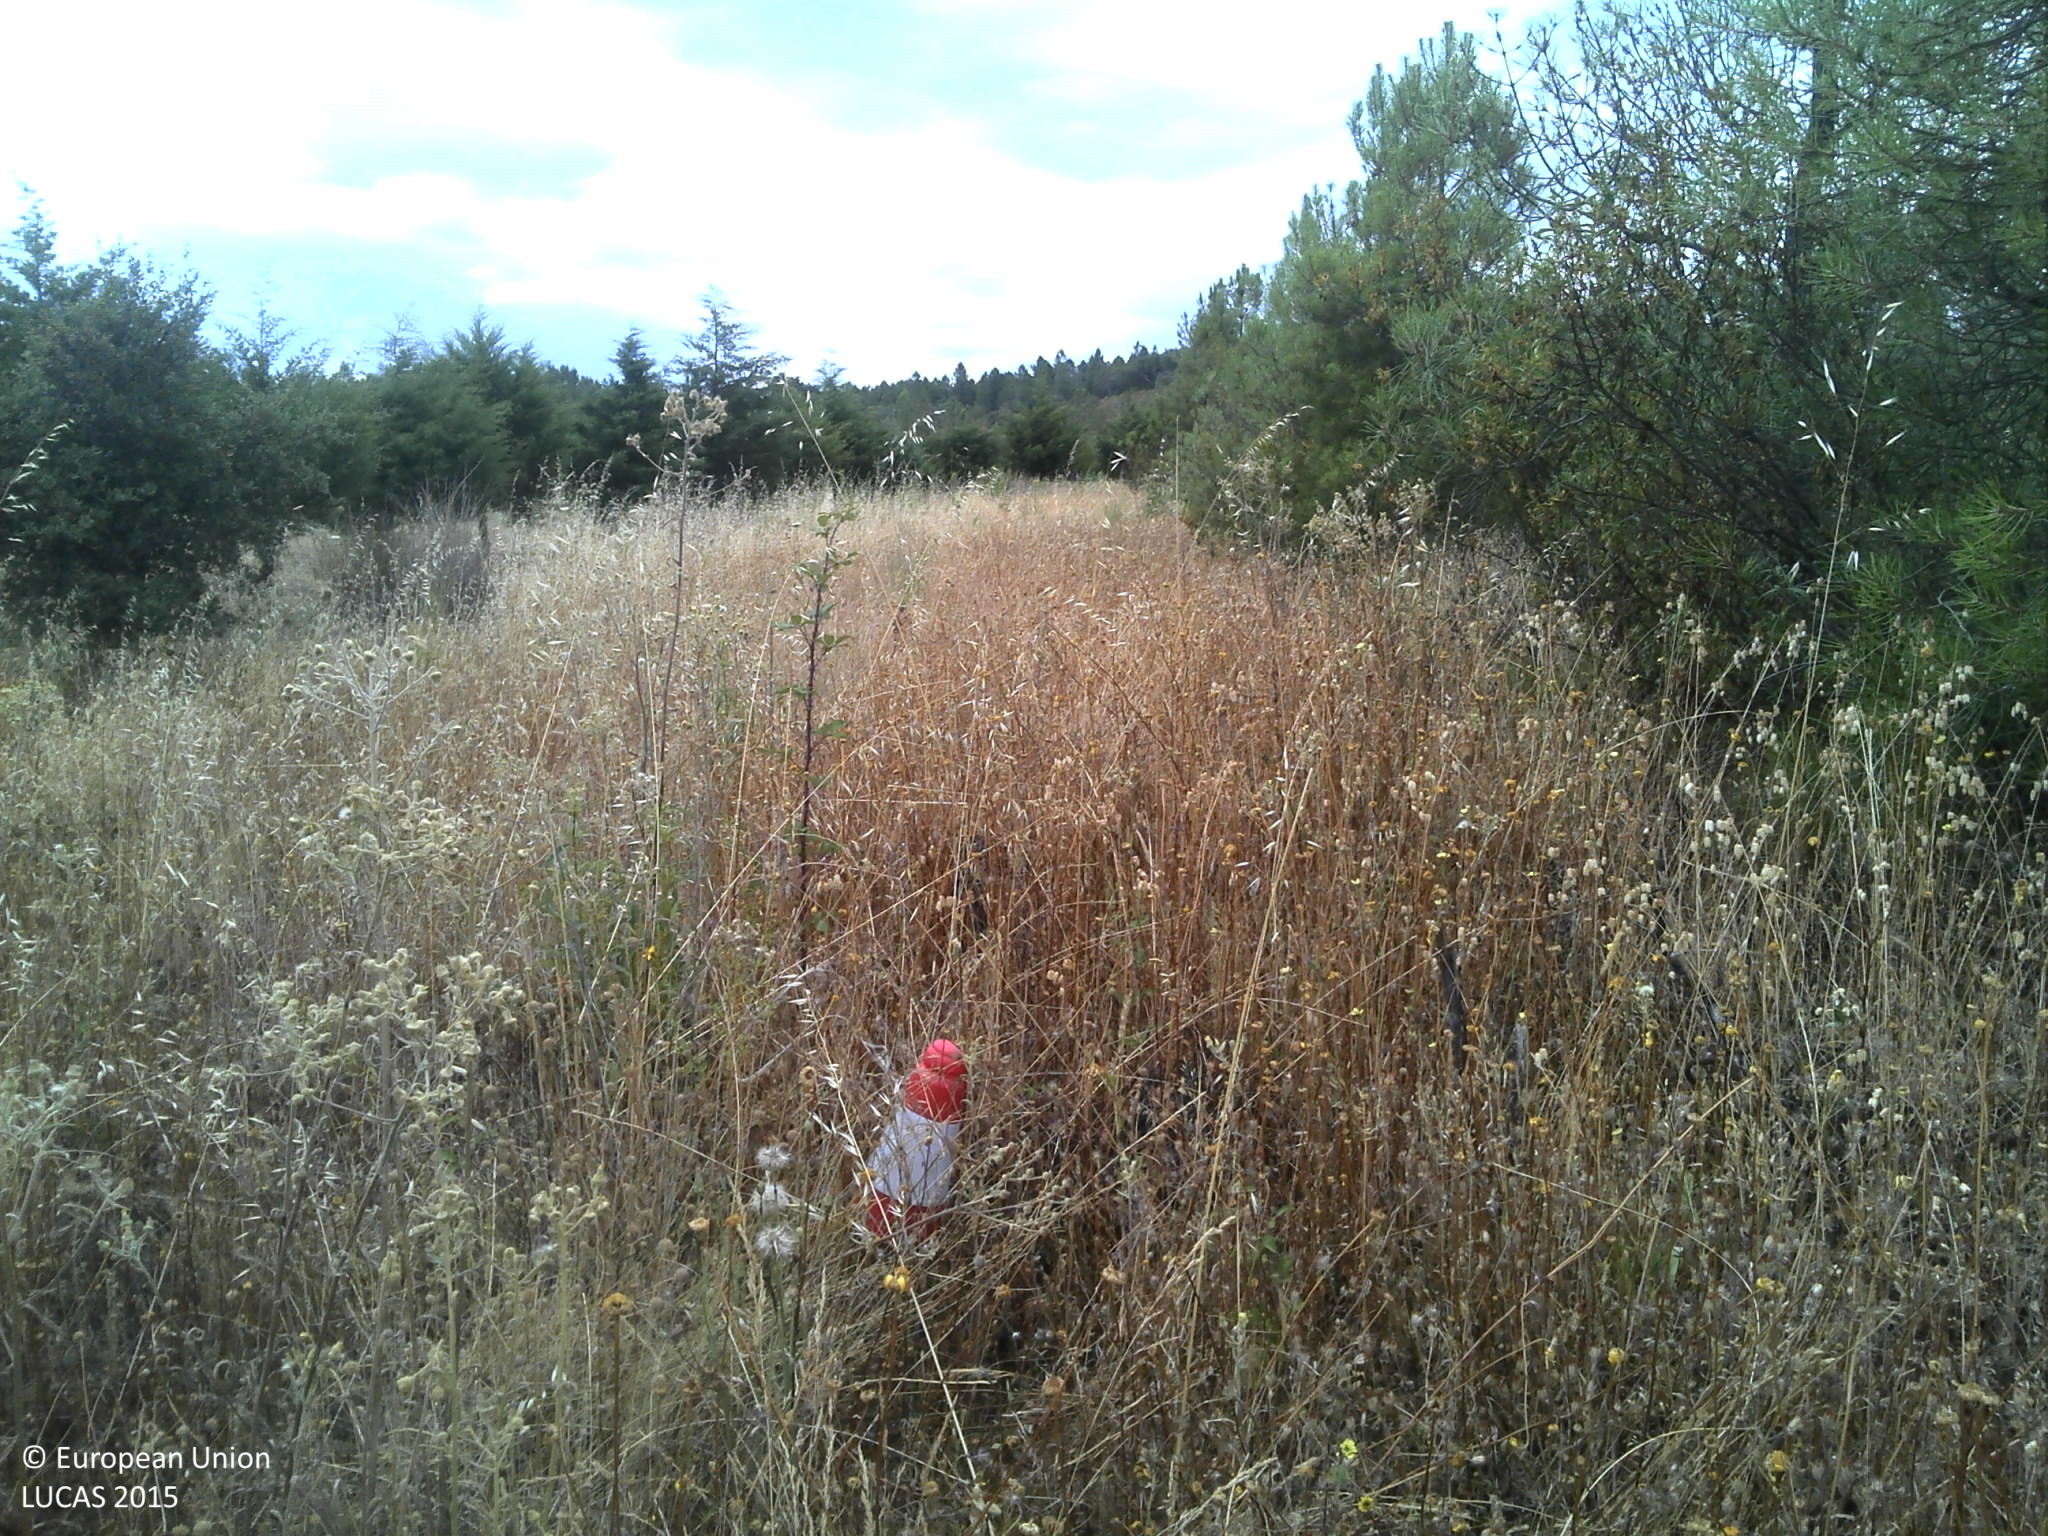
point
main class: Woodland
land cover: Pine dominated coniferous woodland
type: coniferous forest of the mediterranean region
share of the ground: 25 - 50 %
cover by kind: coniferous forest trees 45 %, herbaceous plants 35 %, unconsolidated bare surface 20 %
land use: Forestry
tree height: < 5 m
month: June
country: PT
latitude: 40.1471
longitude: -7.2487
